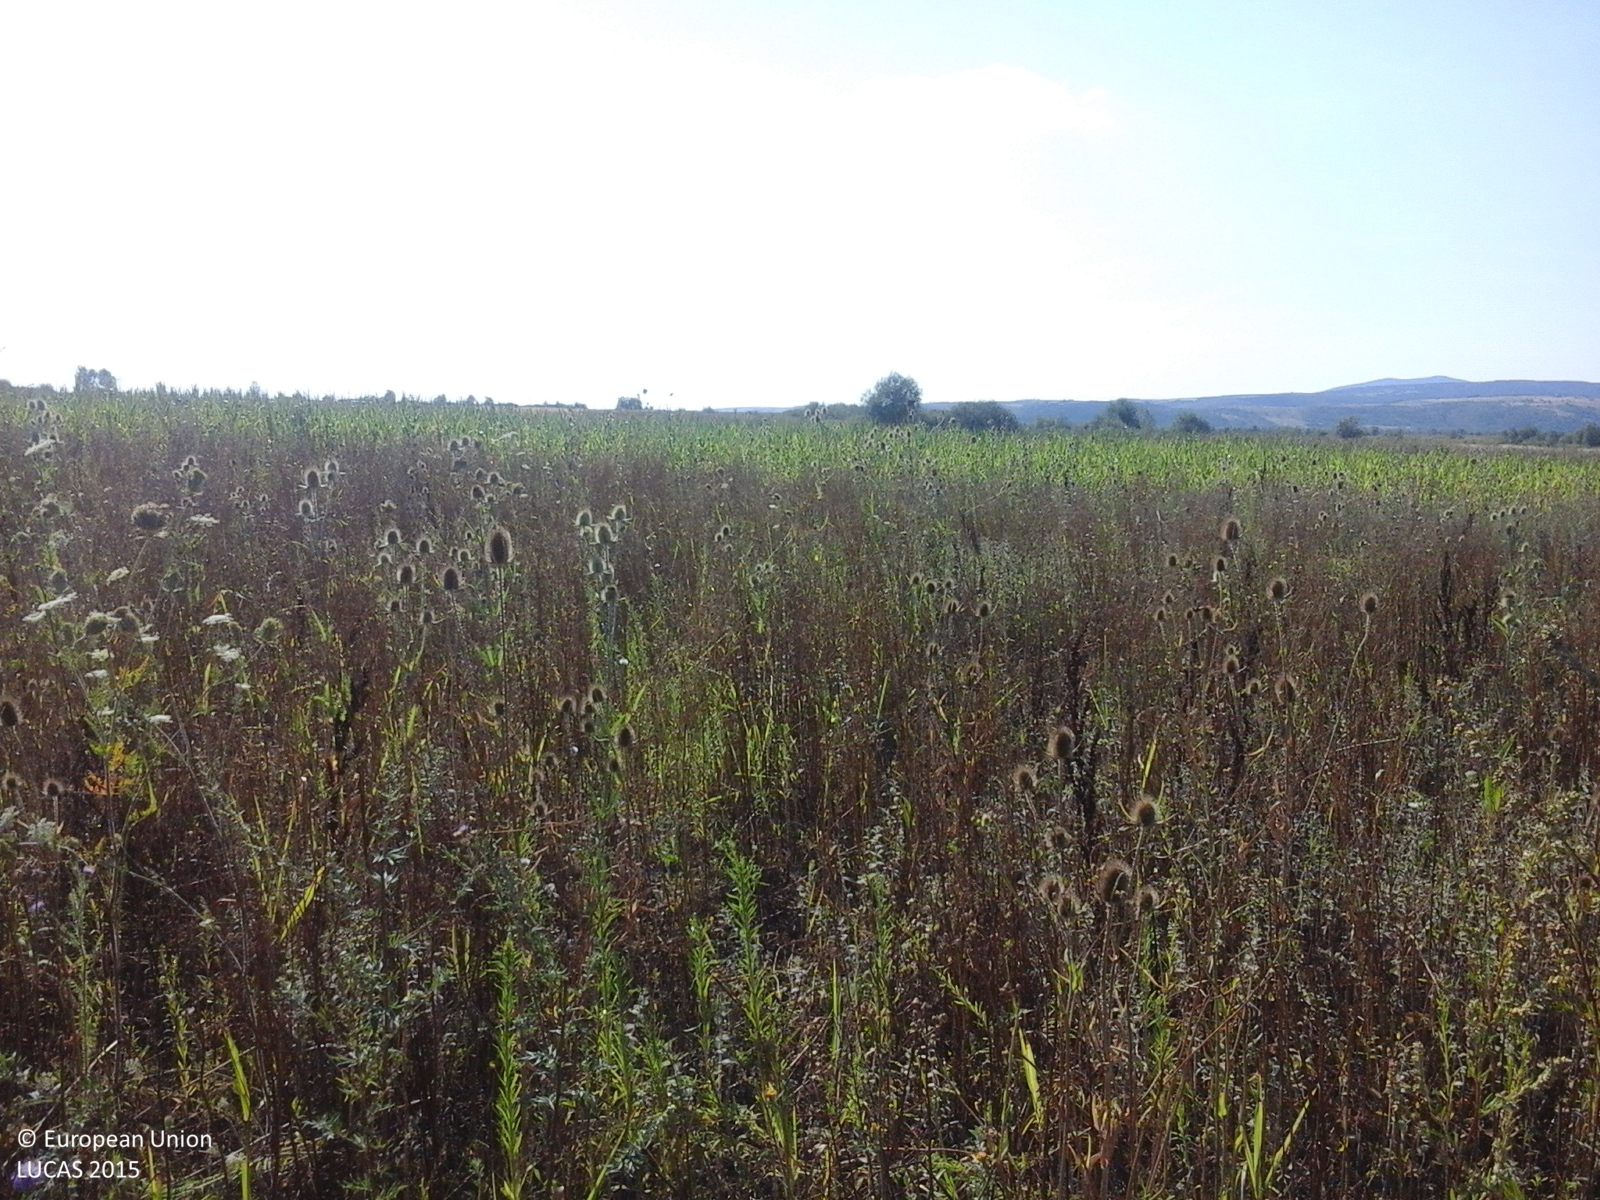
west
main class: Grassland
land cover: Spontaneously vegetated surfaces
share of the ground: > 75 %
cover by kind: herbaceous plants 100 %
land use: Fallow land
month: August
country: RO
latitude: 45.0806
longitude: 21.6040
